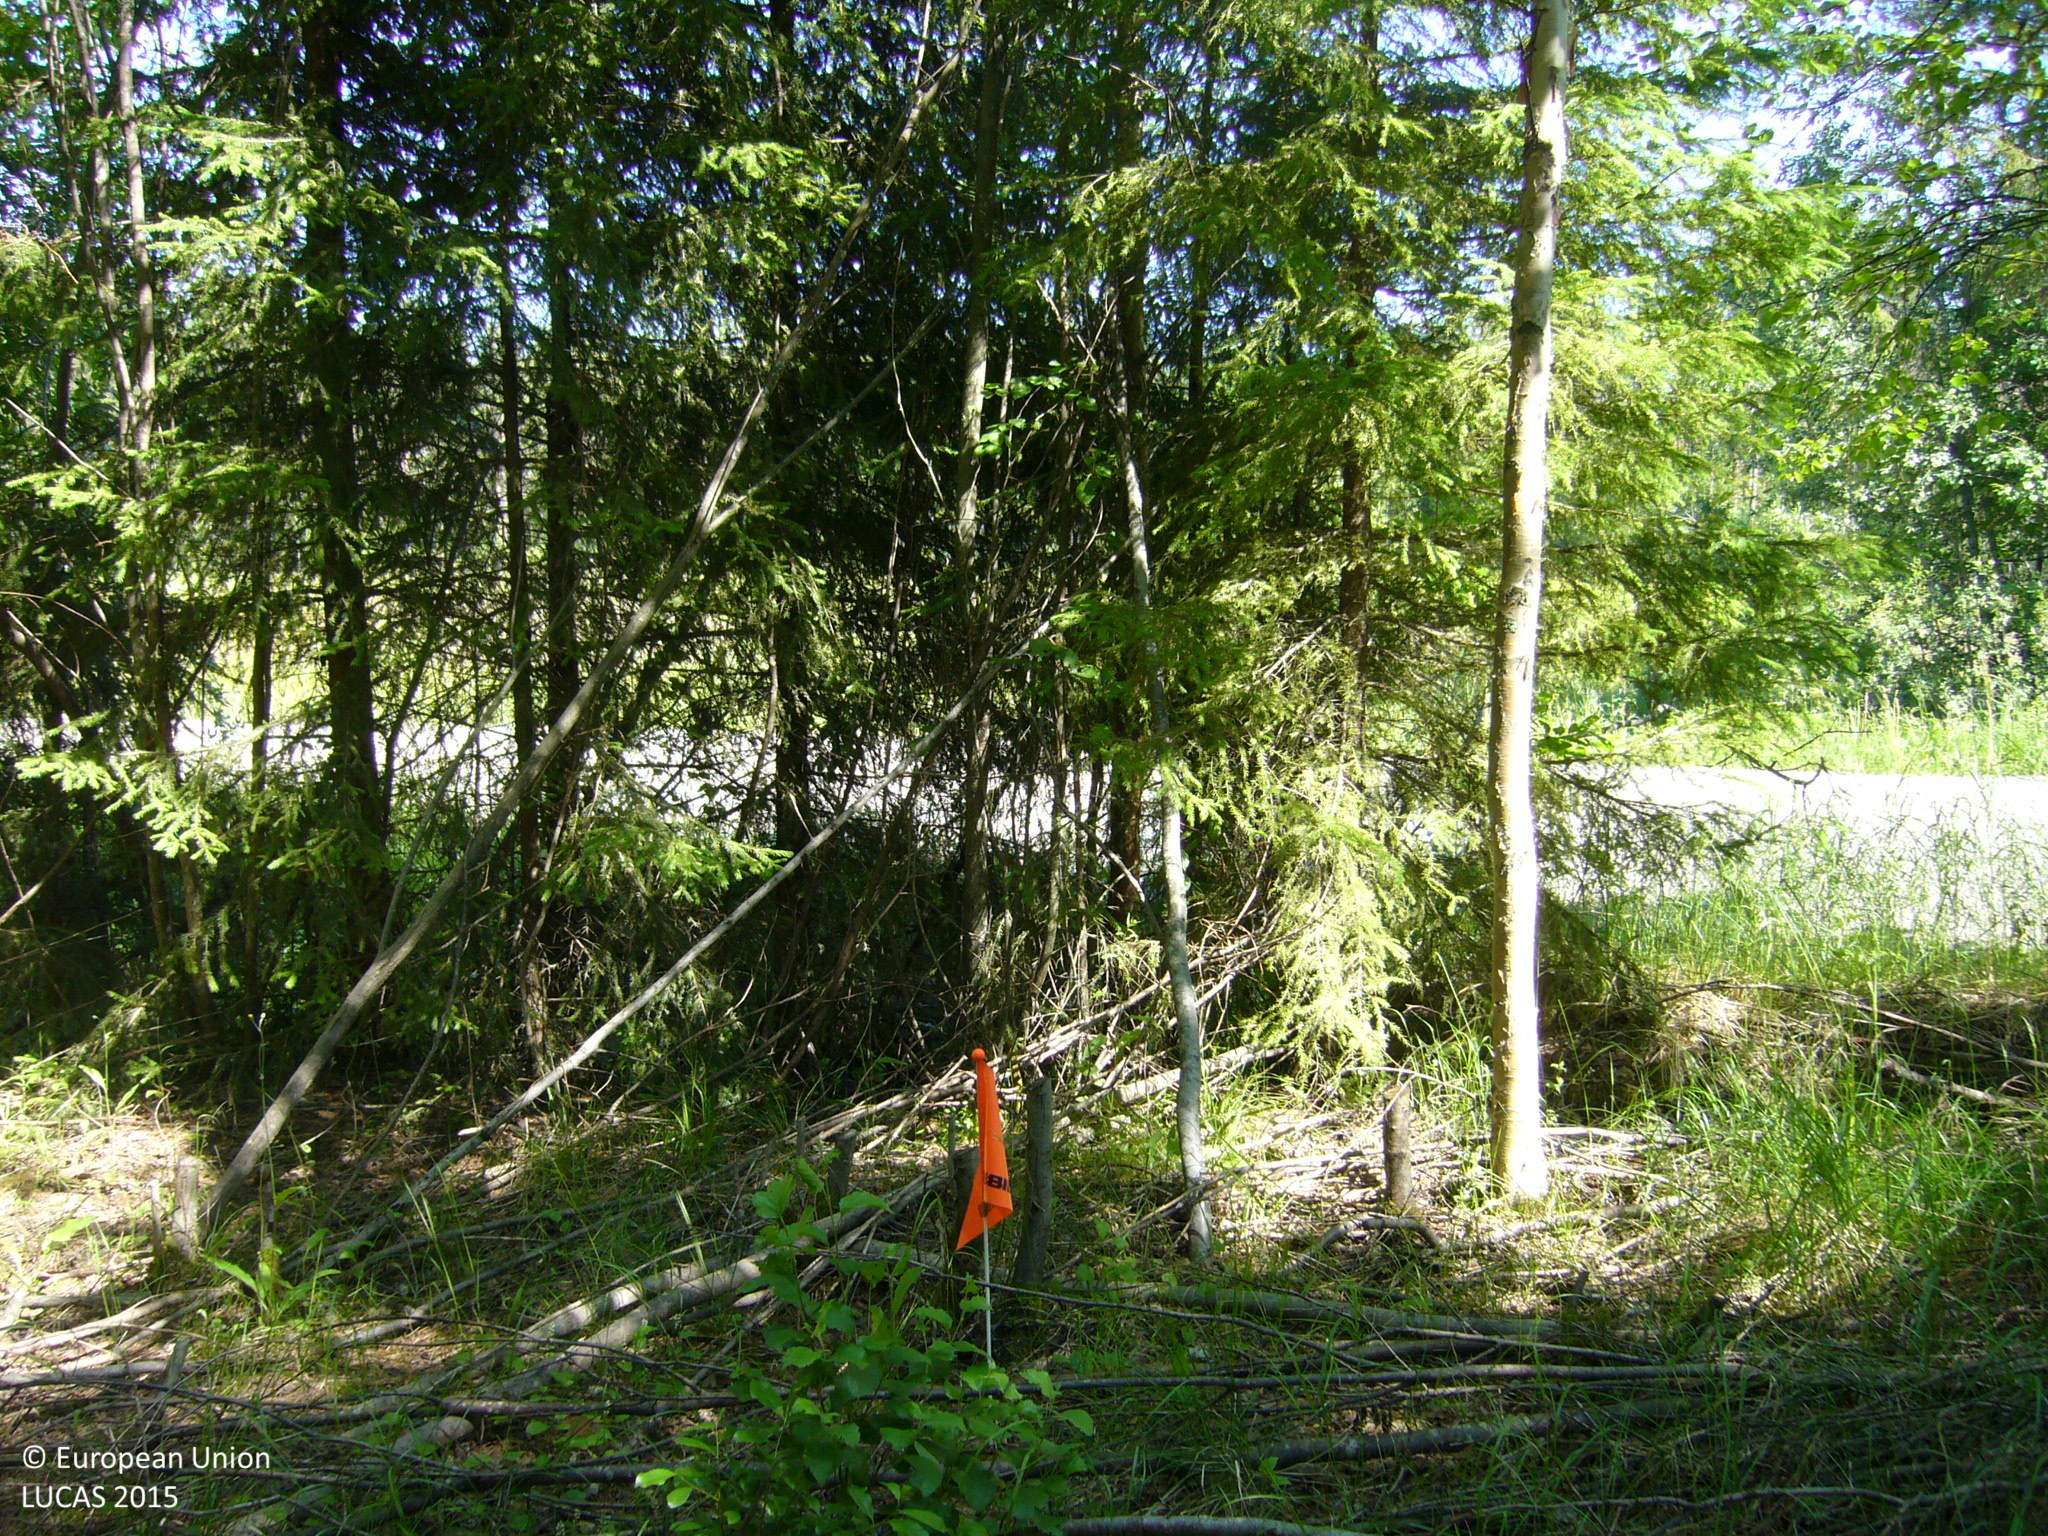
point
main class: Woodland
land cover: Other mixed woodland
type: boreal forest
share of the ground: > 75 %
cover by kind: broadleaved forest trees 50 %, coniferous forest trees 30 %, shrubs 20 %
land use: Forestry
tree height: > 5 m
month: July
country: FI
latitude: 63.3464
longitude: 25.9179
